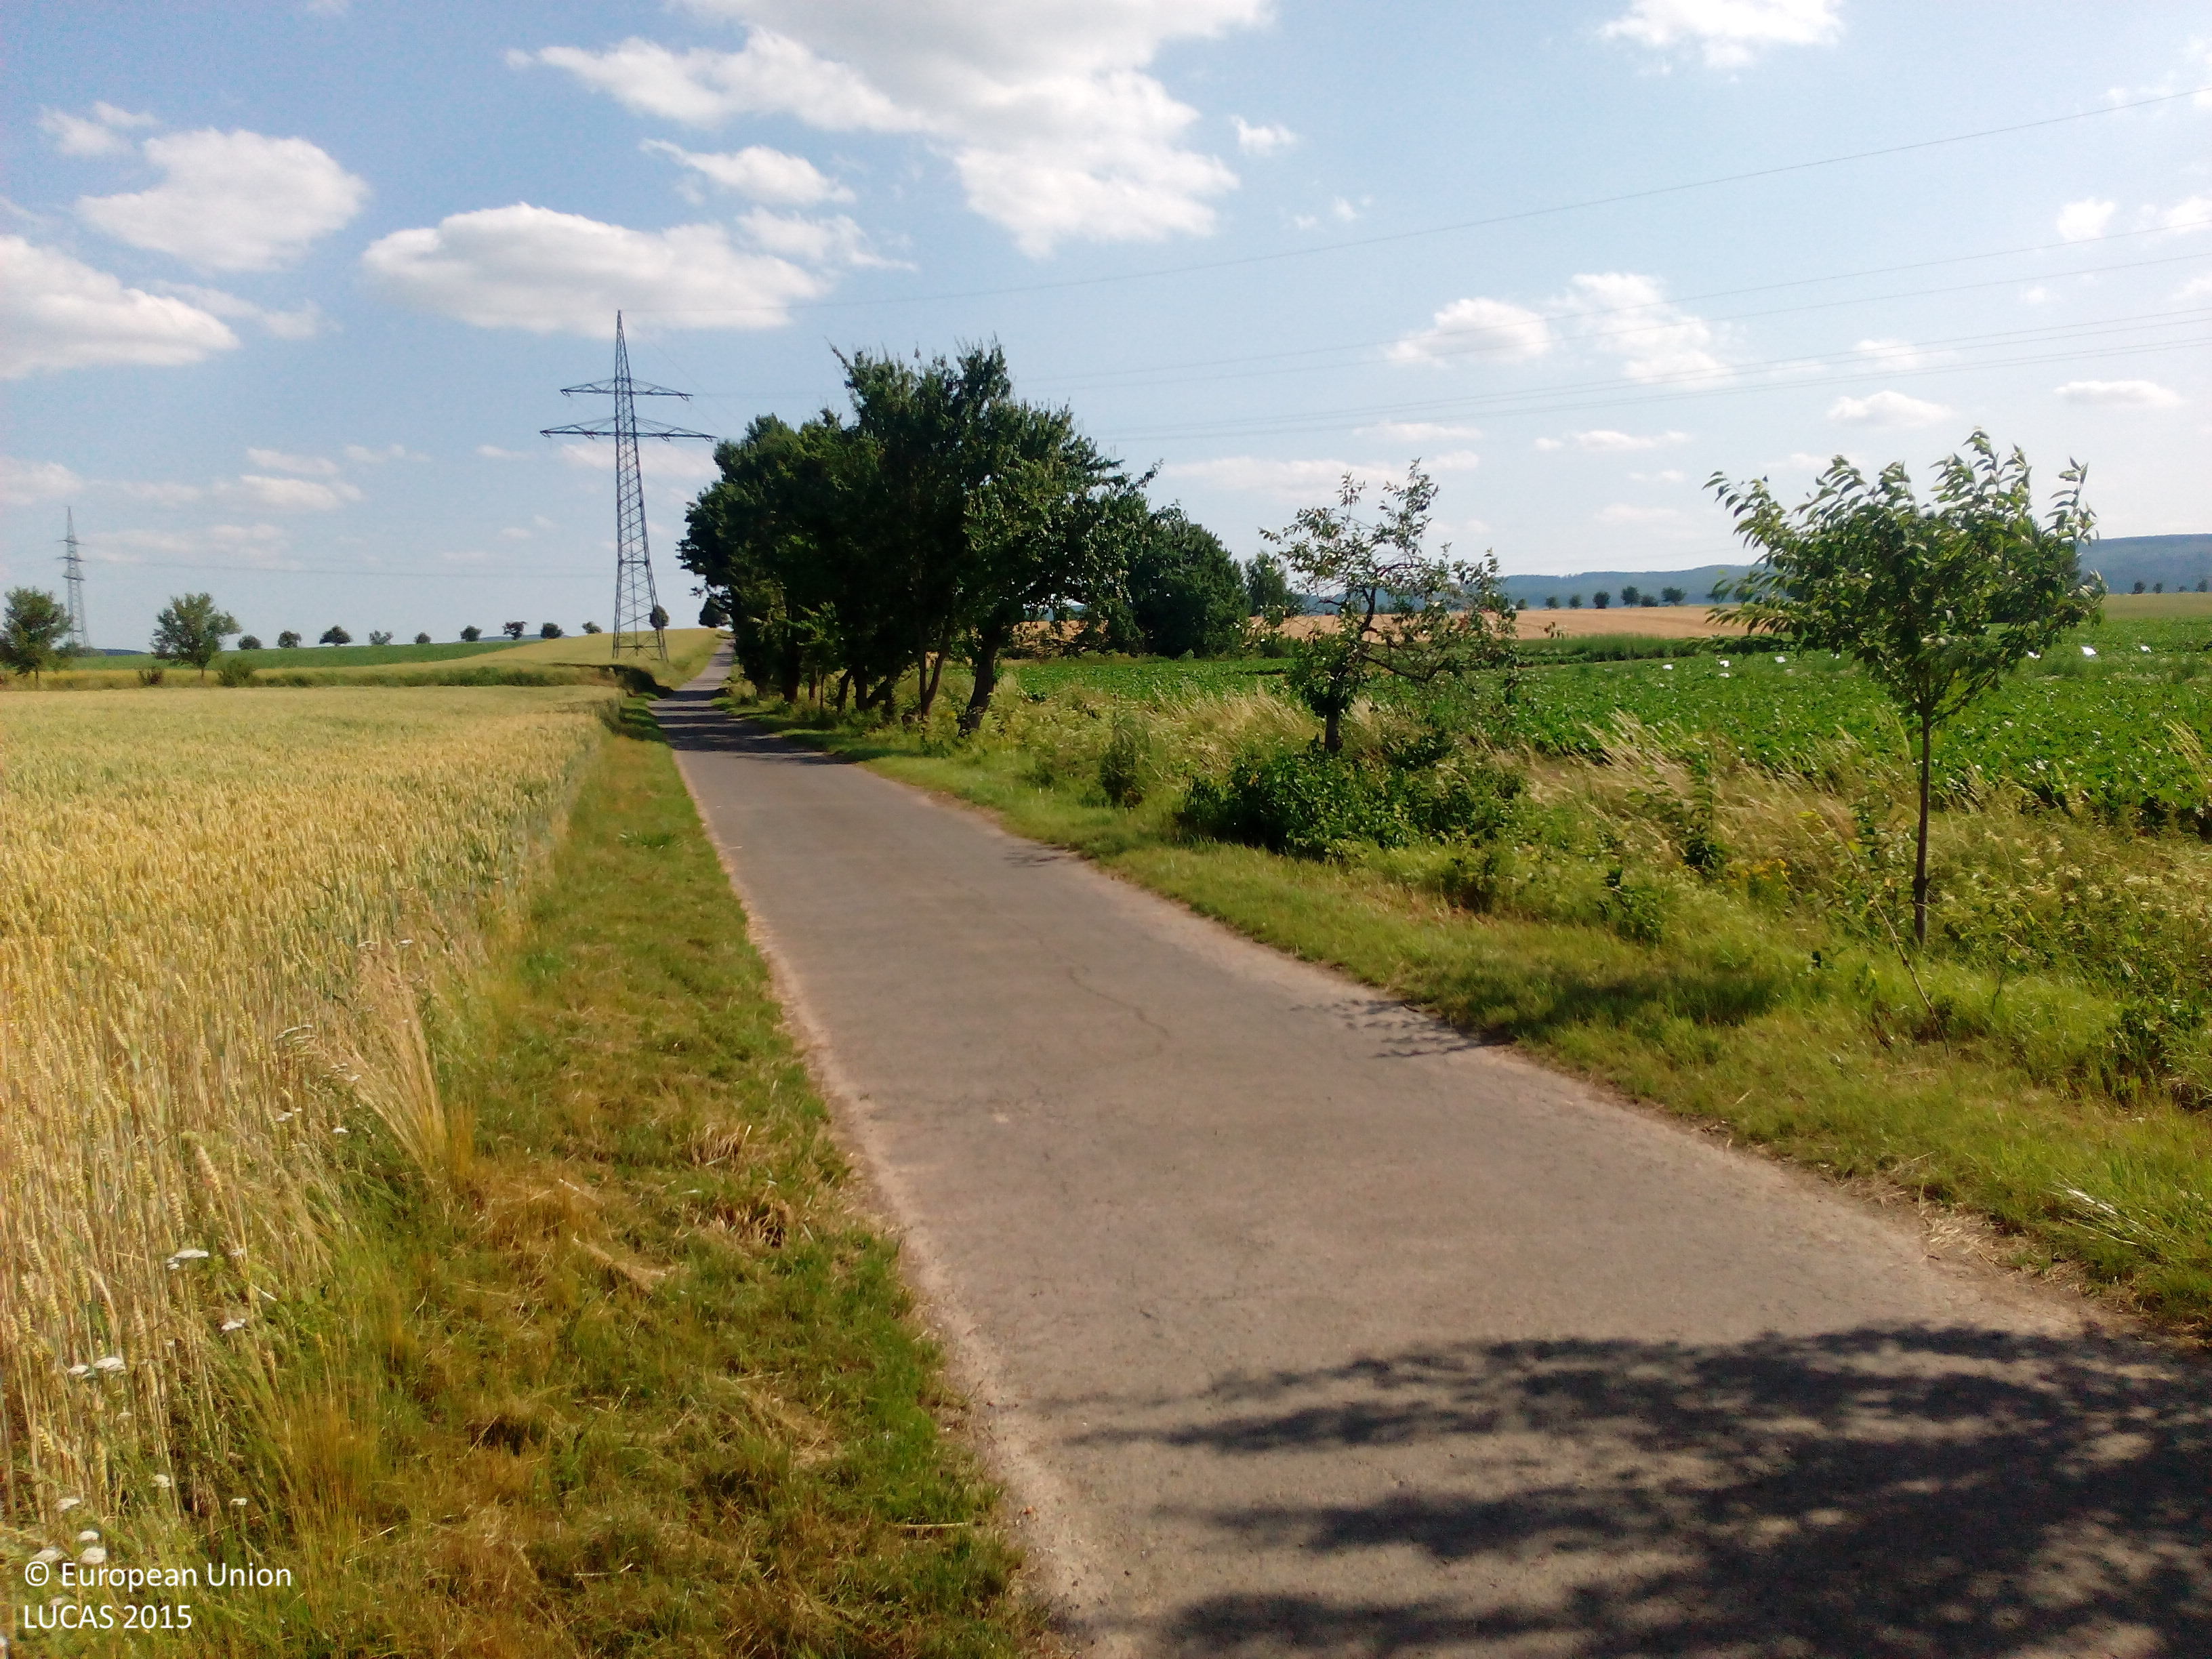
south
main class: Cropland
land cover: Common wheat
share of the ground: > 75 %
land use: Agriculture (excluding fallow land and kitchen gardens)
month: July
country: DE
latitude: 51.8022
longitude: 9.8695
